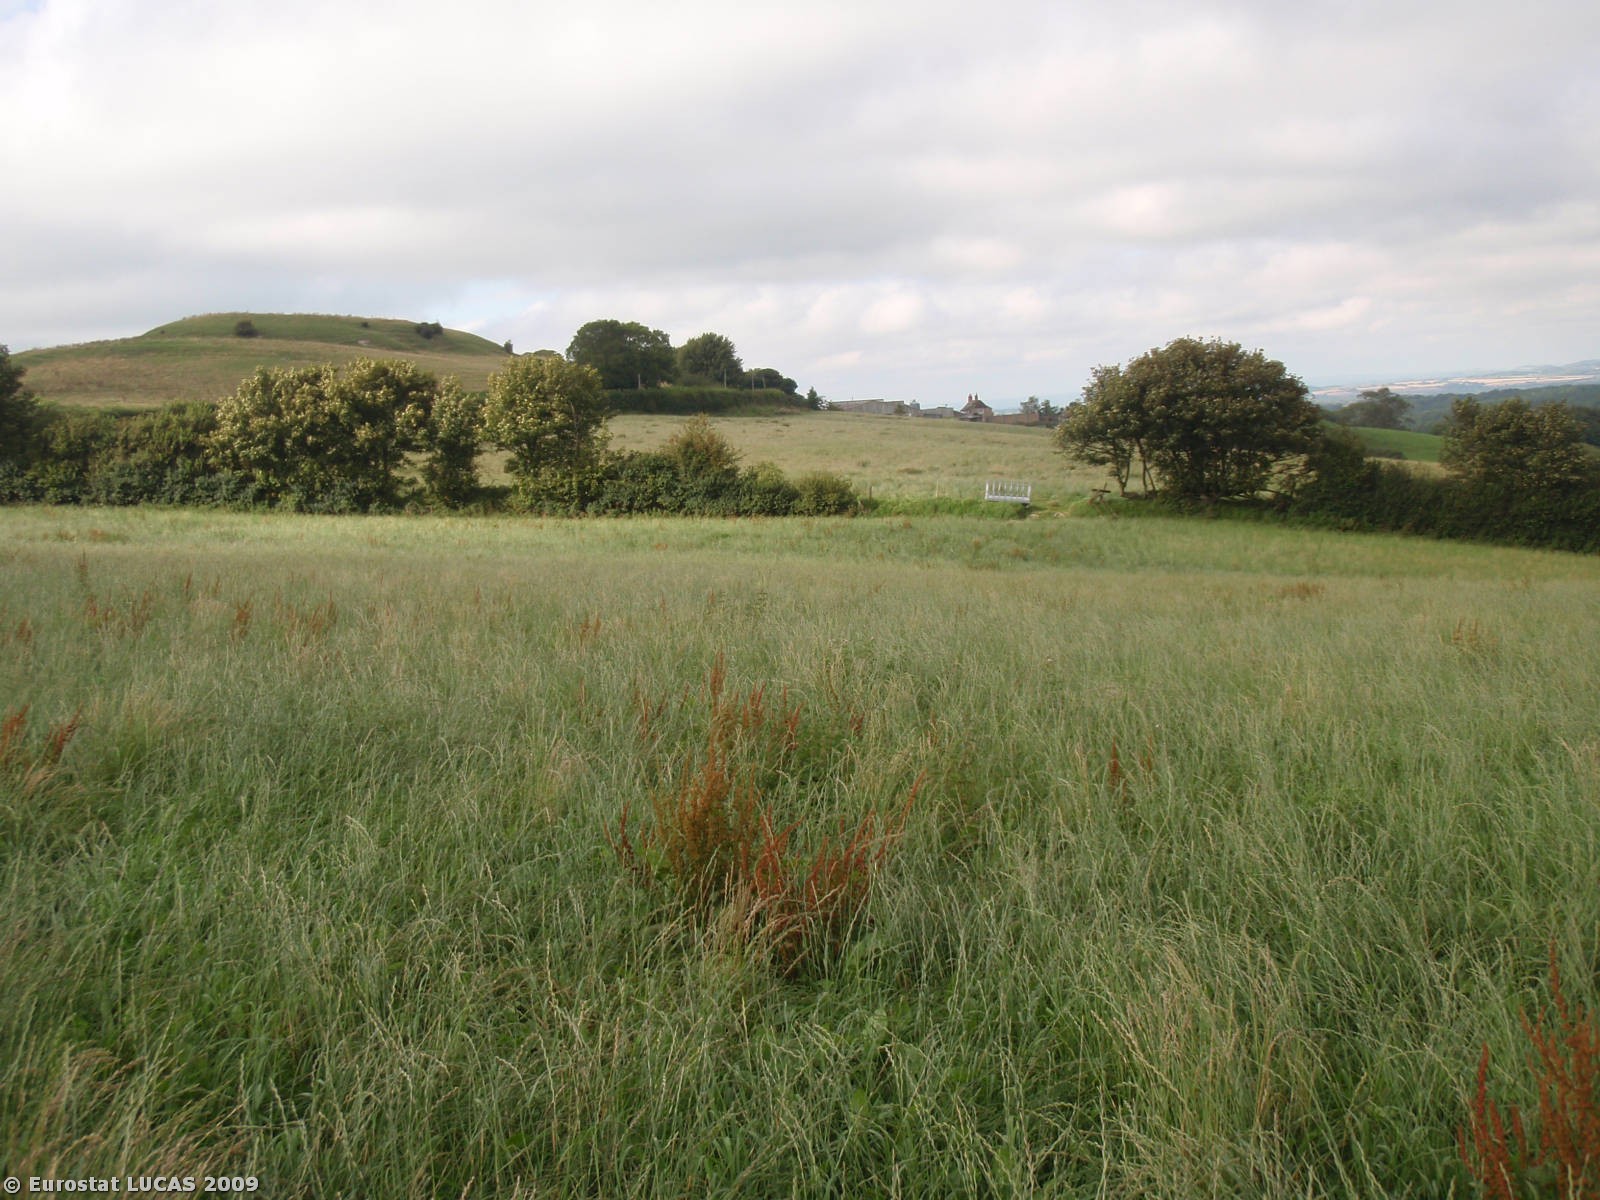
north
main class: Grassland
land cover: Grassland without tree/shrub cover
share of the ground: > 75 %
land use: Agriculture (excluding fallow land and kitchen gardens)
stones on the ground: < 10 %
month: August
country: GB
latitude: 50.8430
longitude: -2.6370
